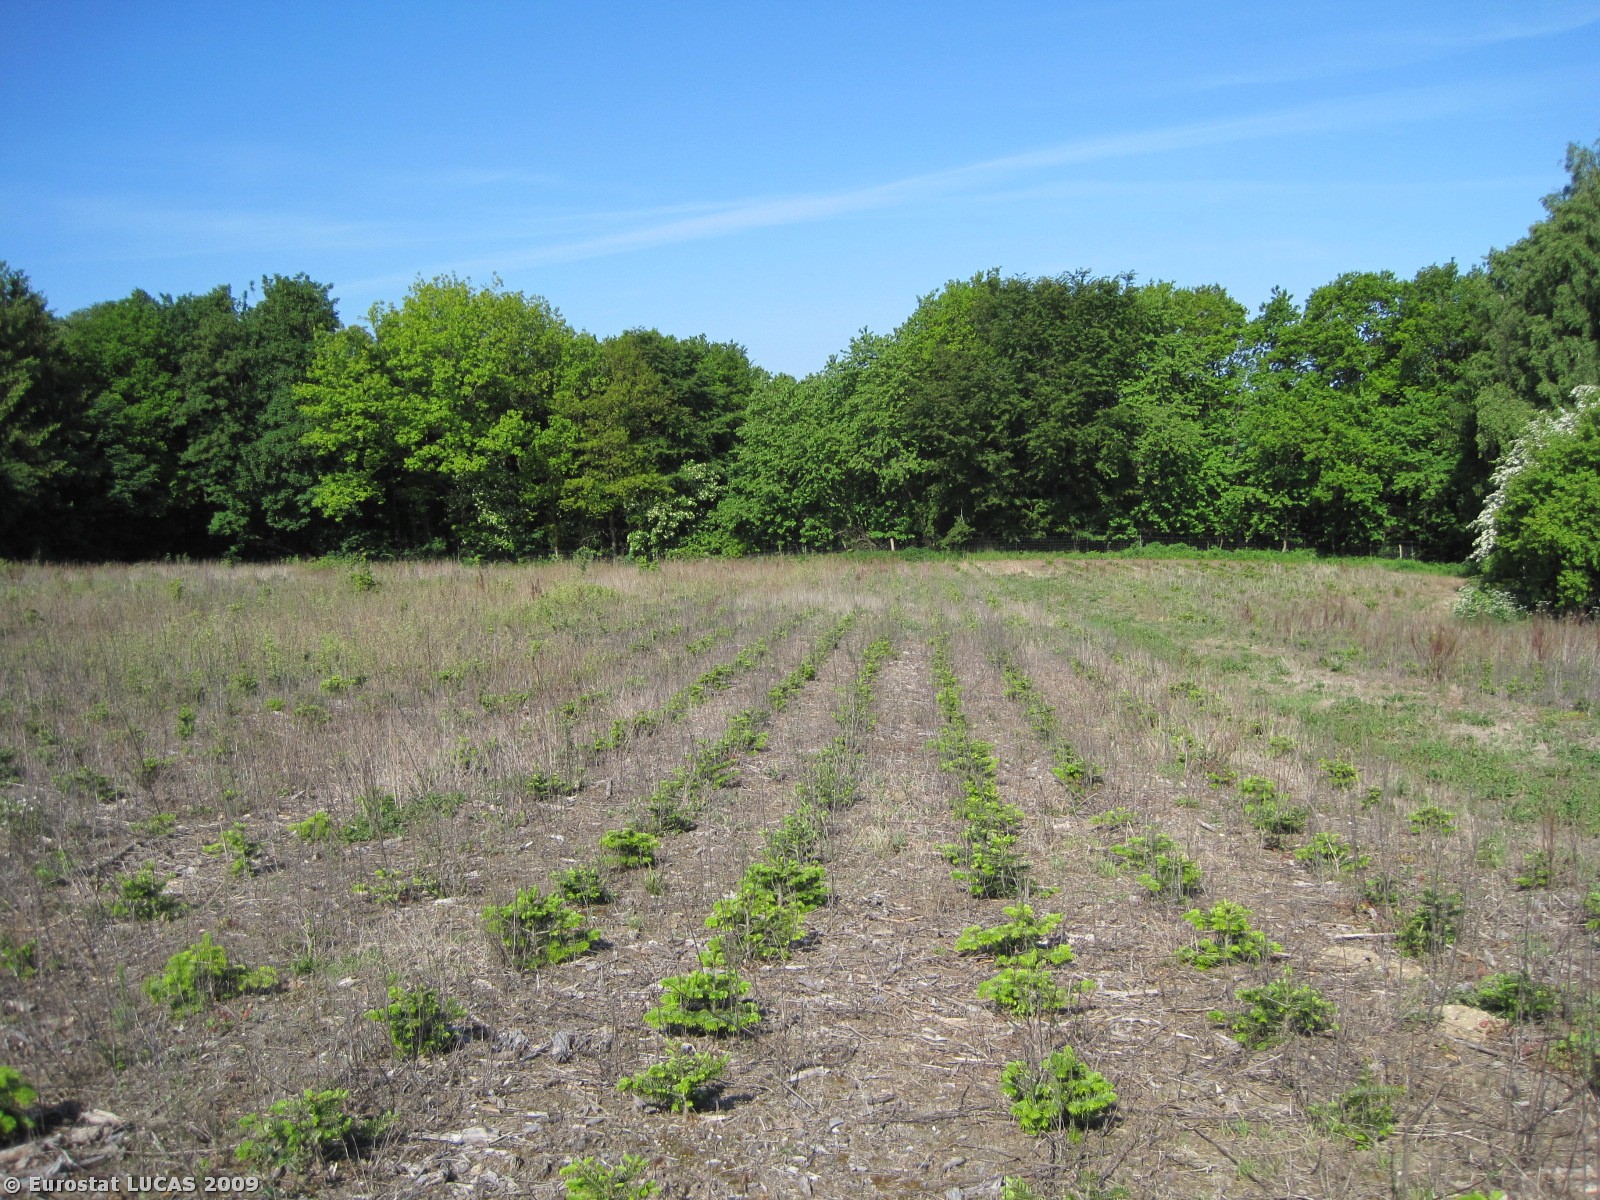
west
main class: Woodland
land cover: Coniferous woodland
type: plantations and self-sown exotic forest
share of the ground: < 10 %
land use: Forestry
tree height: > 5 m
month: May
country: DK
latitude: 56.5292
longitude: 10.1461
